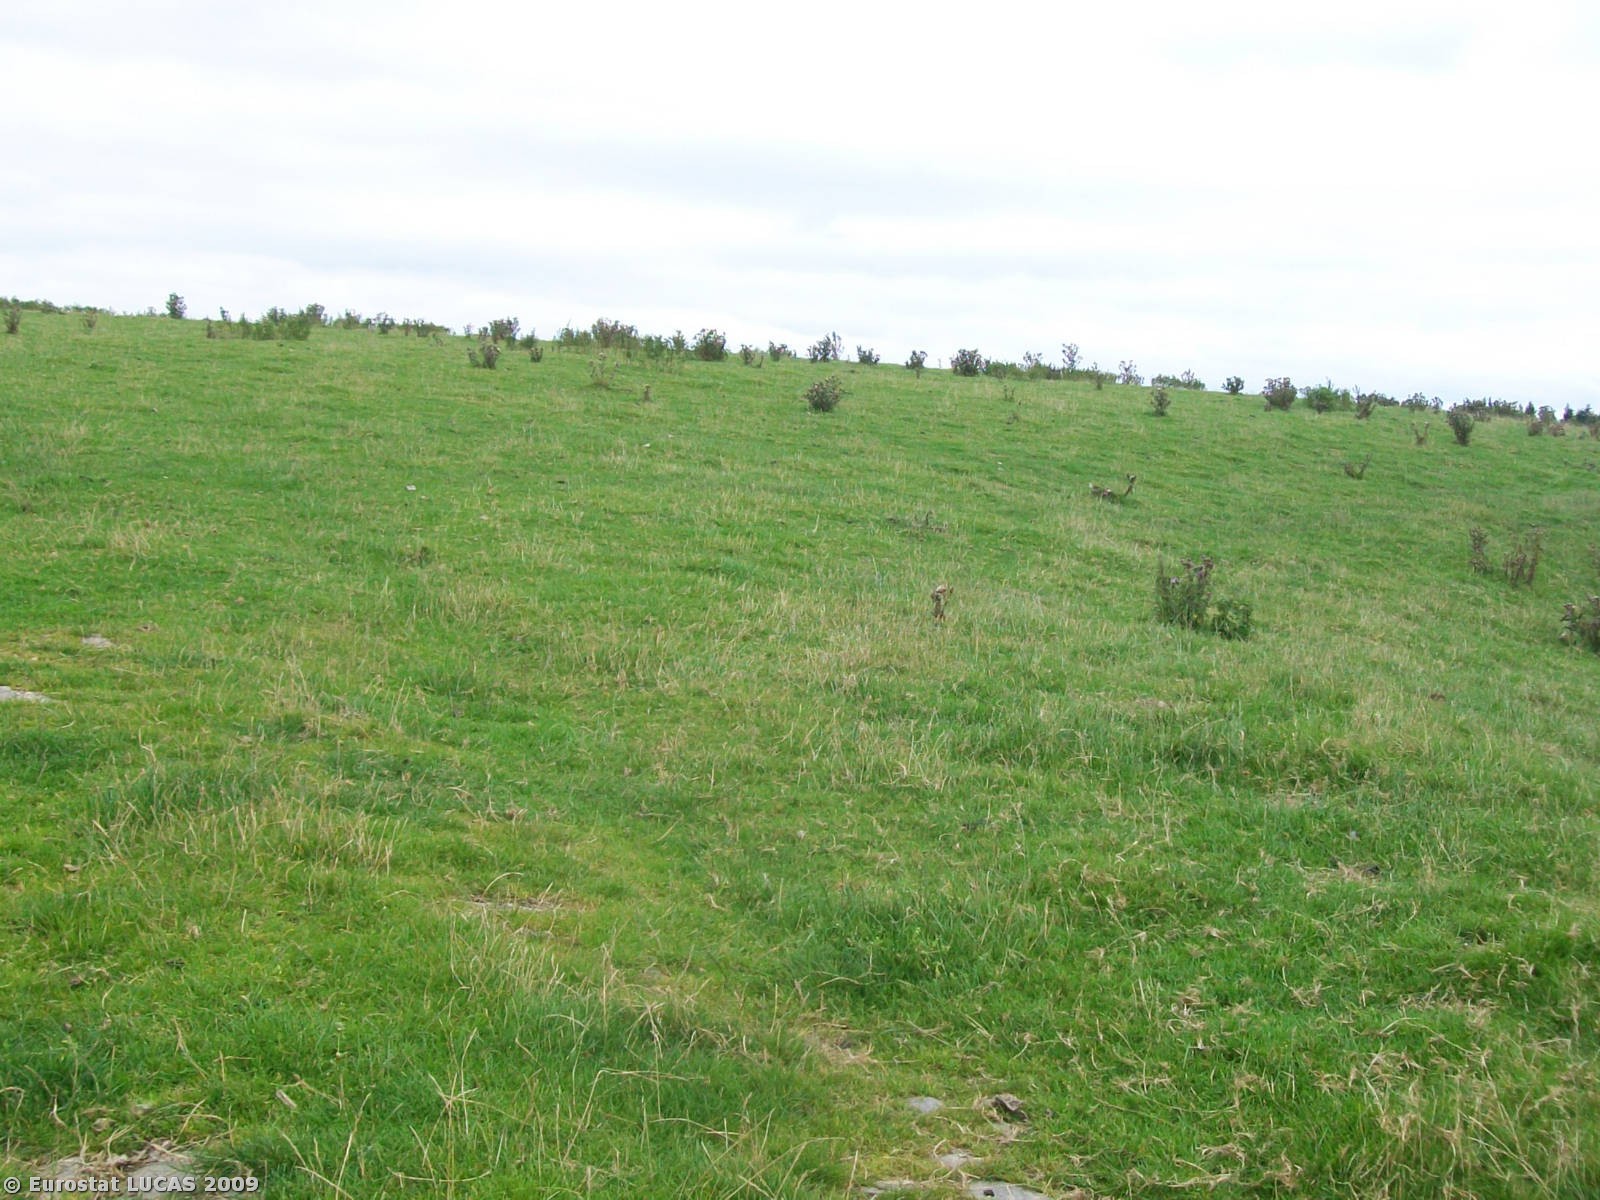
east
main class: Grassland
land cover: Grassland without tree/shrub cover
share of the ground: > 75 %
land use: Agriculture (excluding fallow land and kitchen gardens)
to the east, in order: Grassland without tree/shrub cover; Fences; Grassland without tree/shrub cover; Shrubland without tree cover; Tracks
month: August
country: GB
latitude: 52.4992
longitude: -3.1436
